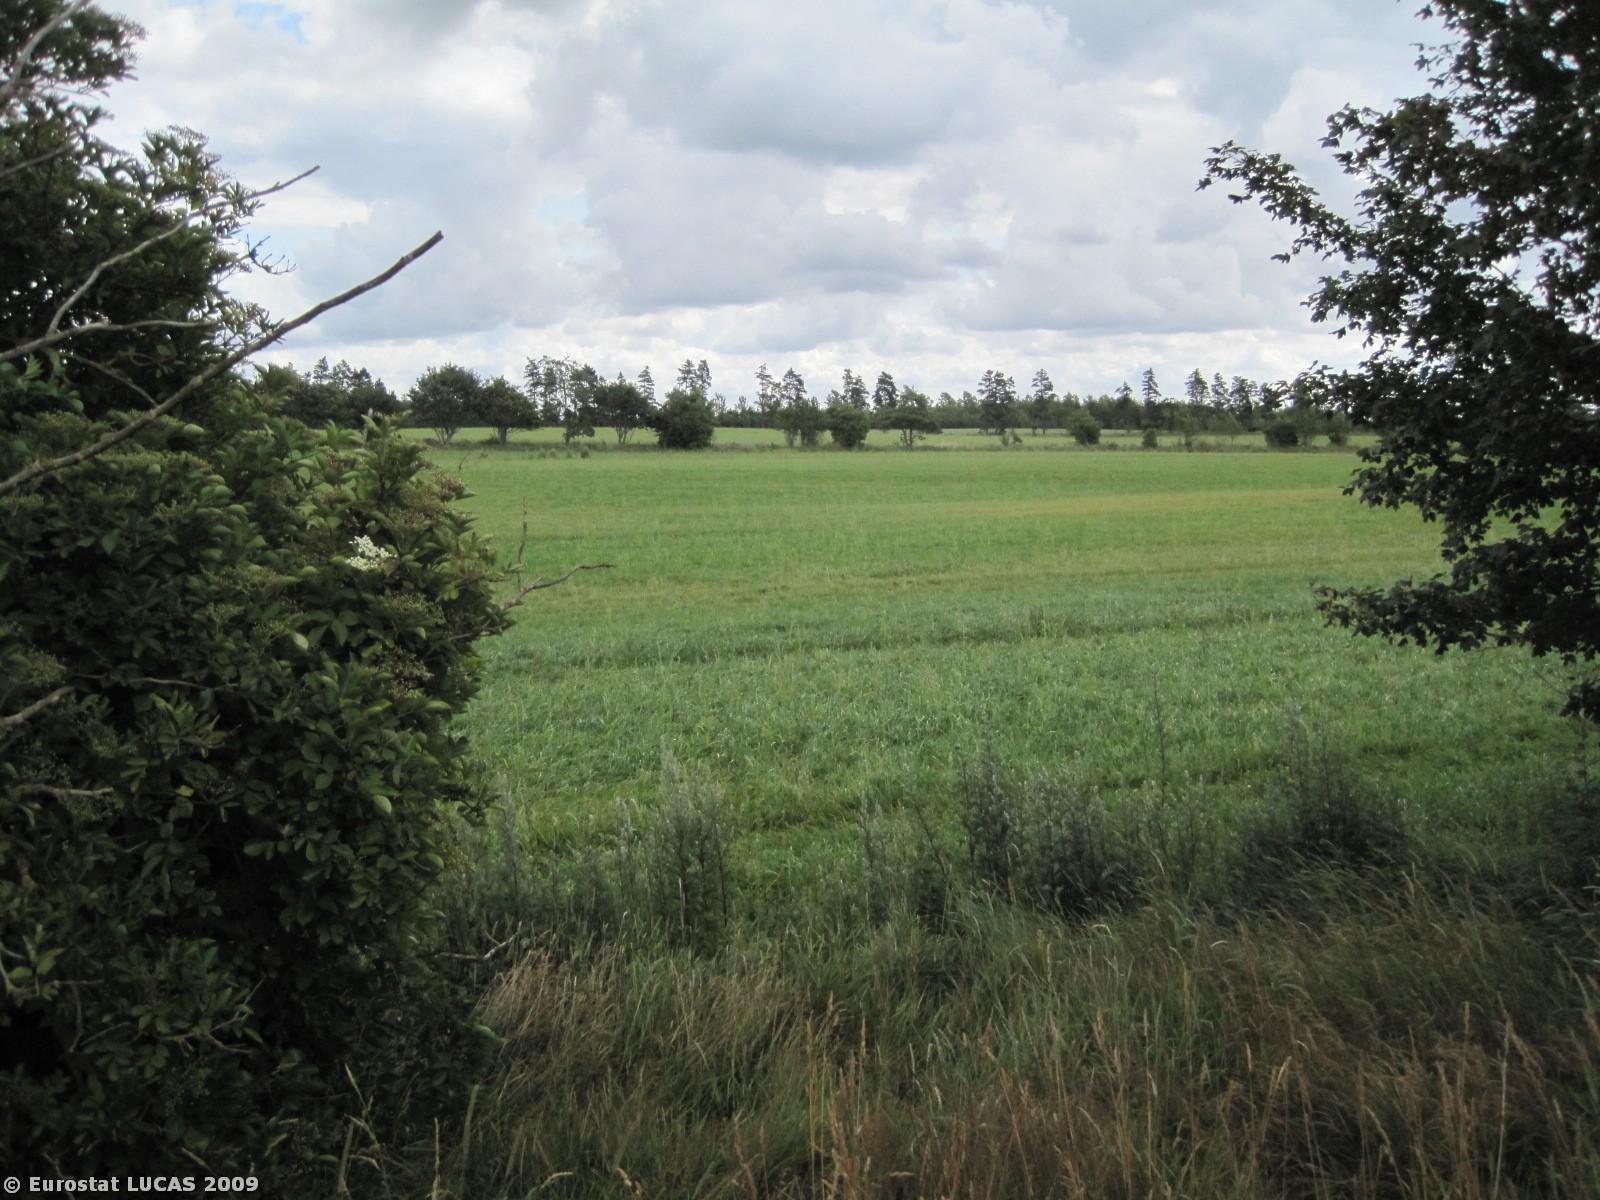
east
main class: Cropland
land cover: Barley
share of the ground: > 75 %
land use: Agriculture (excluding fallow land and kitchen gardens)
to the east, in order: Barley; Grassland without tree/shrub cover; Temporary grasslands; Grass margins; Broadleaved woodland; Grass margins; Temporary grasslands
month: July
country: DK
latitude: 56.3804
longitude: 8.8516
